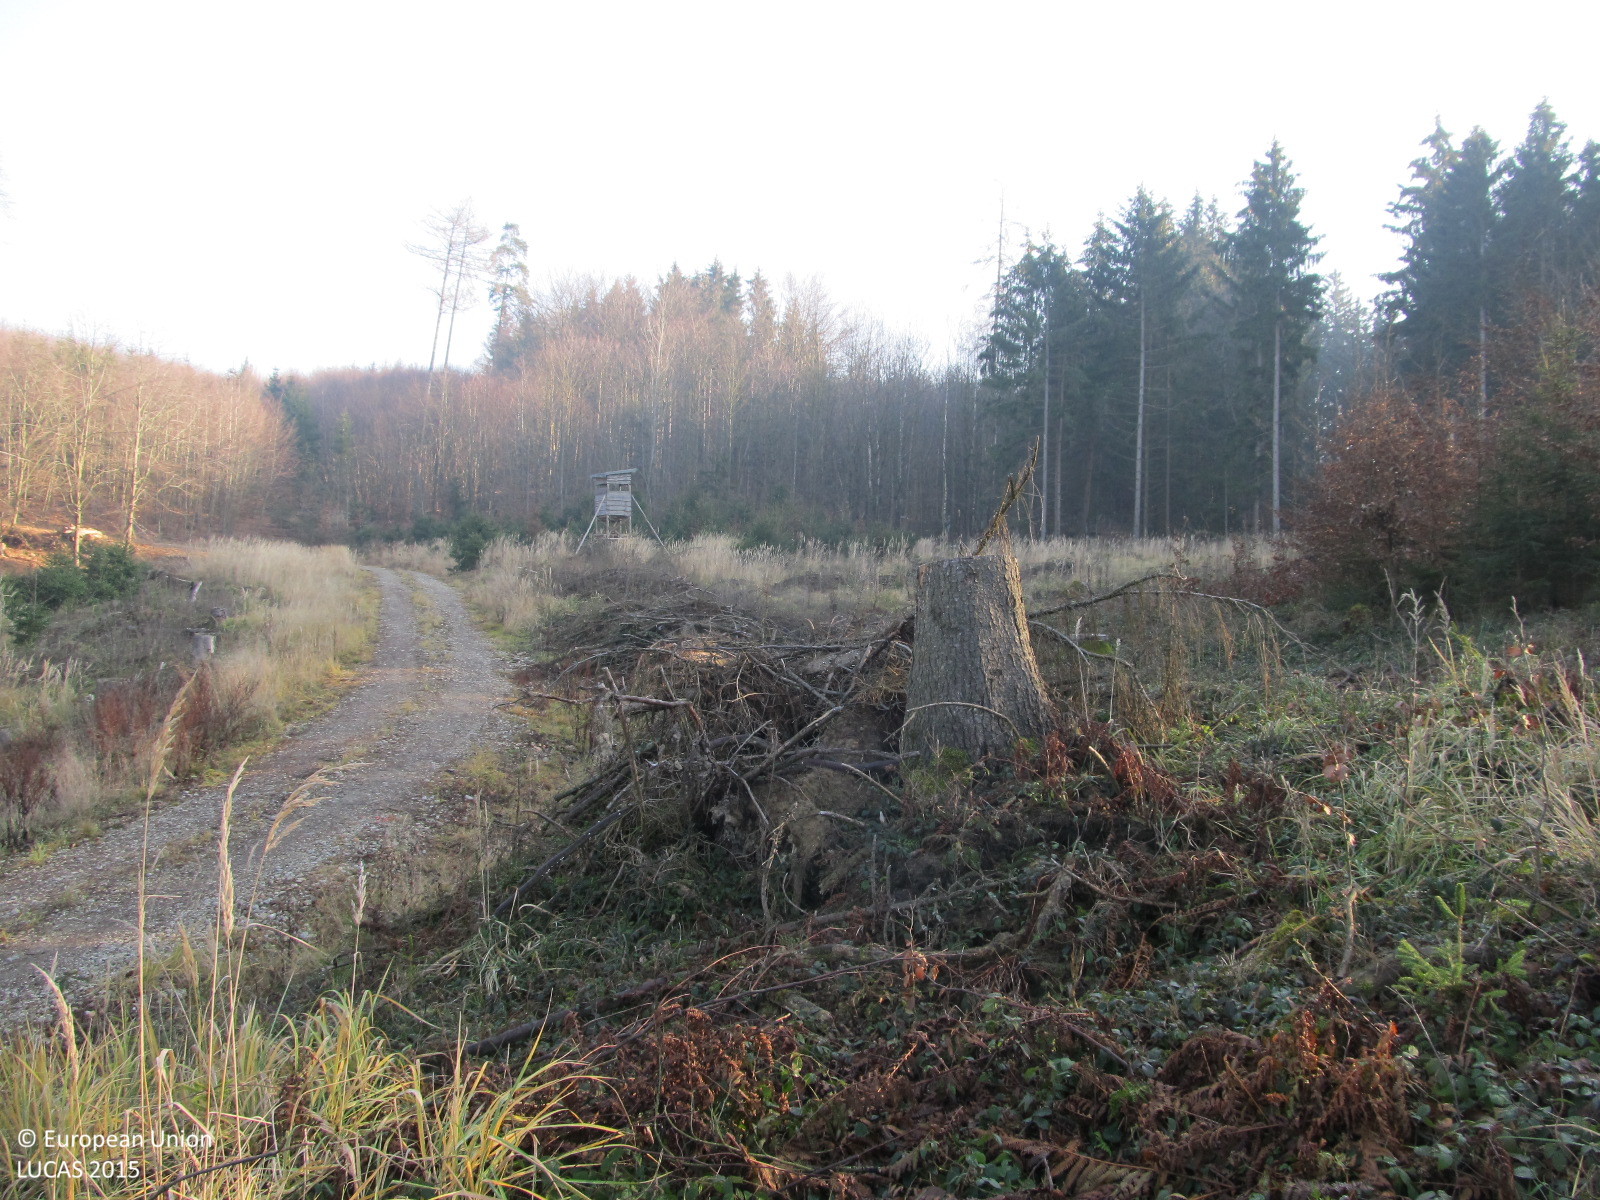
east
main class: Woodland
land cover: Spruce dominated mixed woodland
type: hemiboreal forest and nemoral coniferous forest and mixed broadleaved-coniferous forest
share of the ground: 10 - 25 %
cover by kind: shrubs 70 %, broadleaved forest trees 15 %, herbaceous plants 10 %, coniferous forest trees 5 %
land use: Forestry
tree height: < 5 m
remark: Clear cut
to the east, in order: Spruce dominated mixed woodland; Grassland with sparse tree/shrub cover; Broadleaved woodland; Tracks; Spruce dominated coniferous woodland
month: December
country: AT
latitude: 48.2713
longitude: 15.4050
